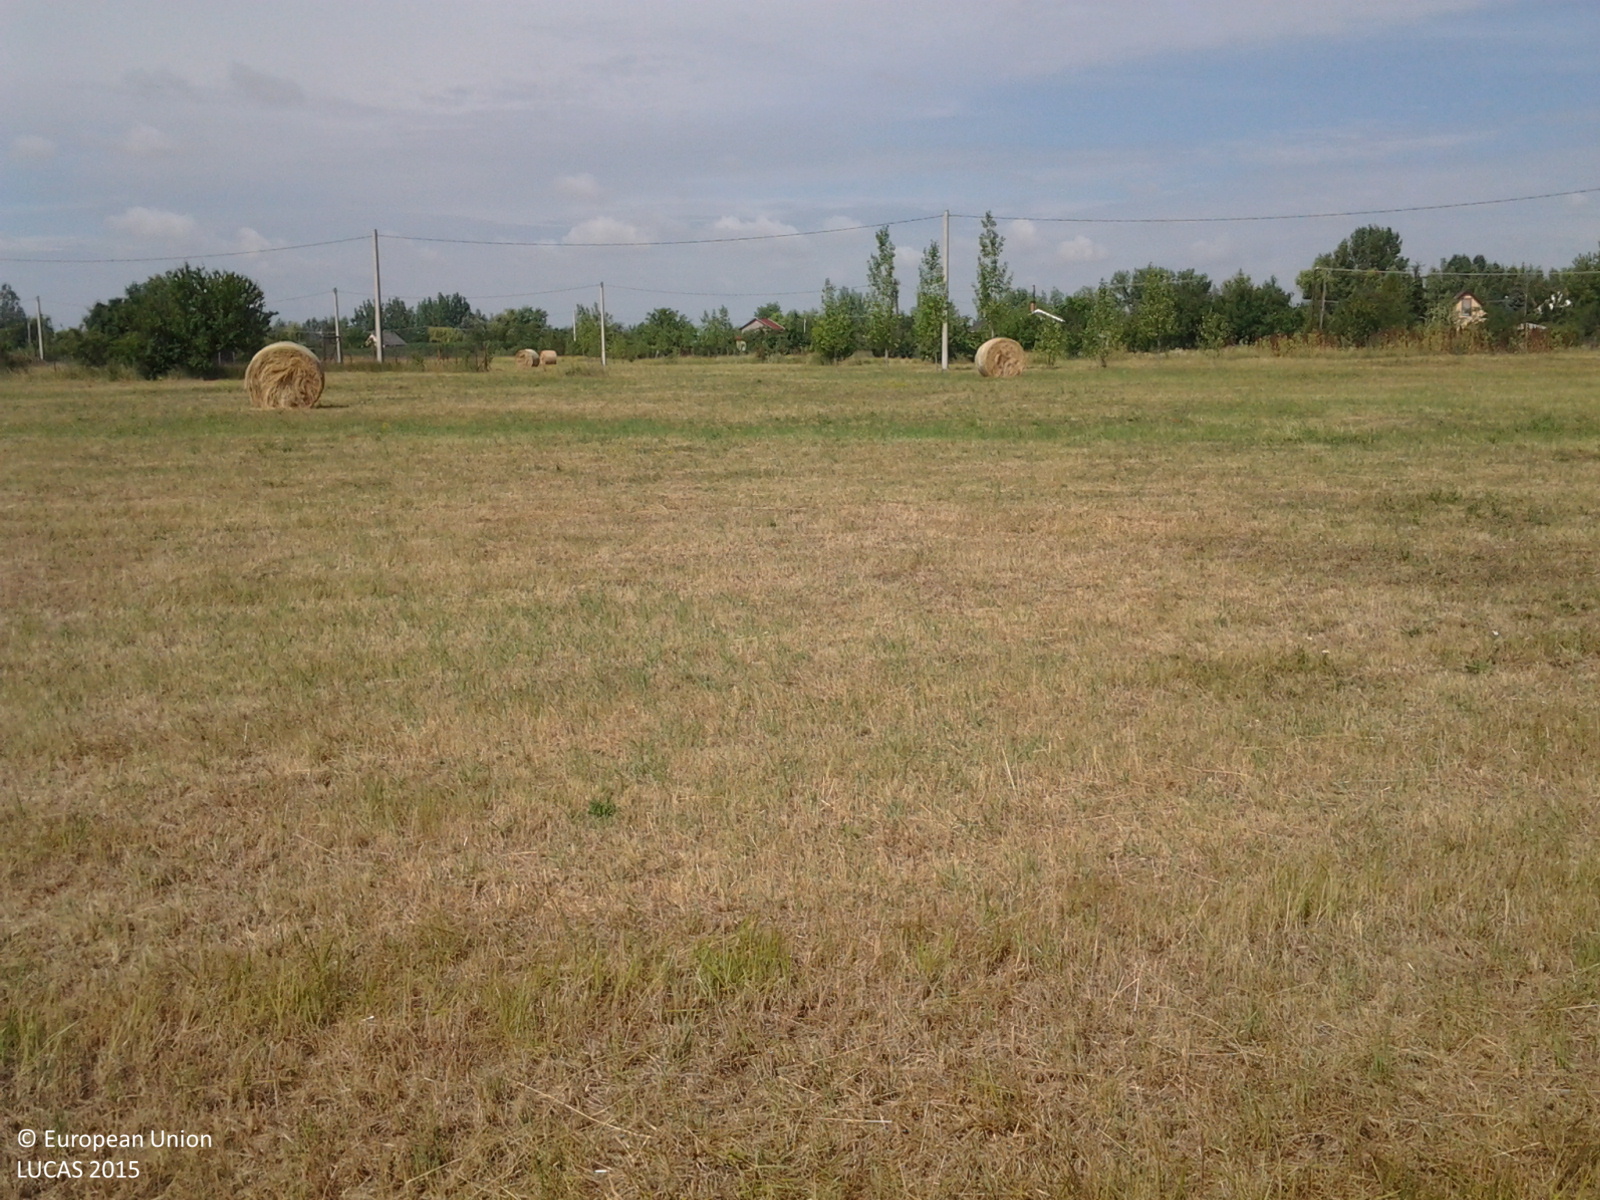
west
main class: Grassland
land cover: Grassland without tree/shrub cover
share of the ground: > 75 %
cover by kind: herbaceous plants 100 %
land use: Agriculture (excluding fallow land and kitchen gardens)
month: June
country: HU
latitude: 47.0824
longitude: 20.1545
